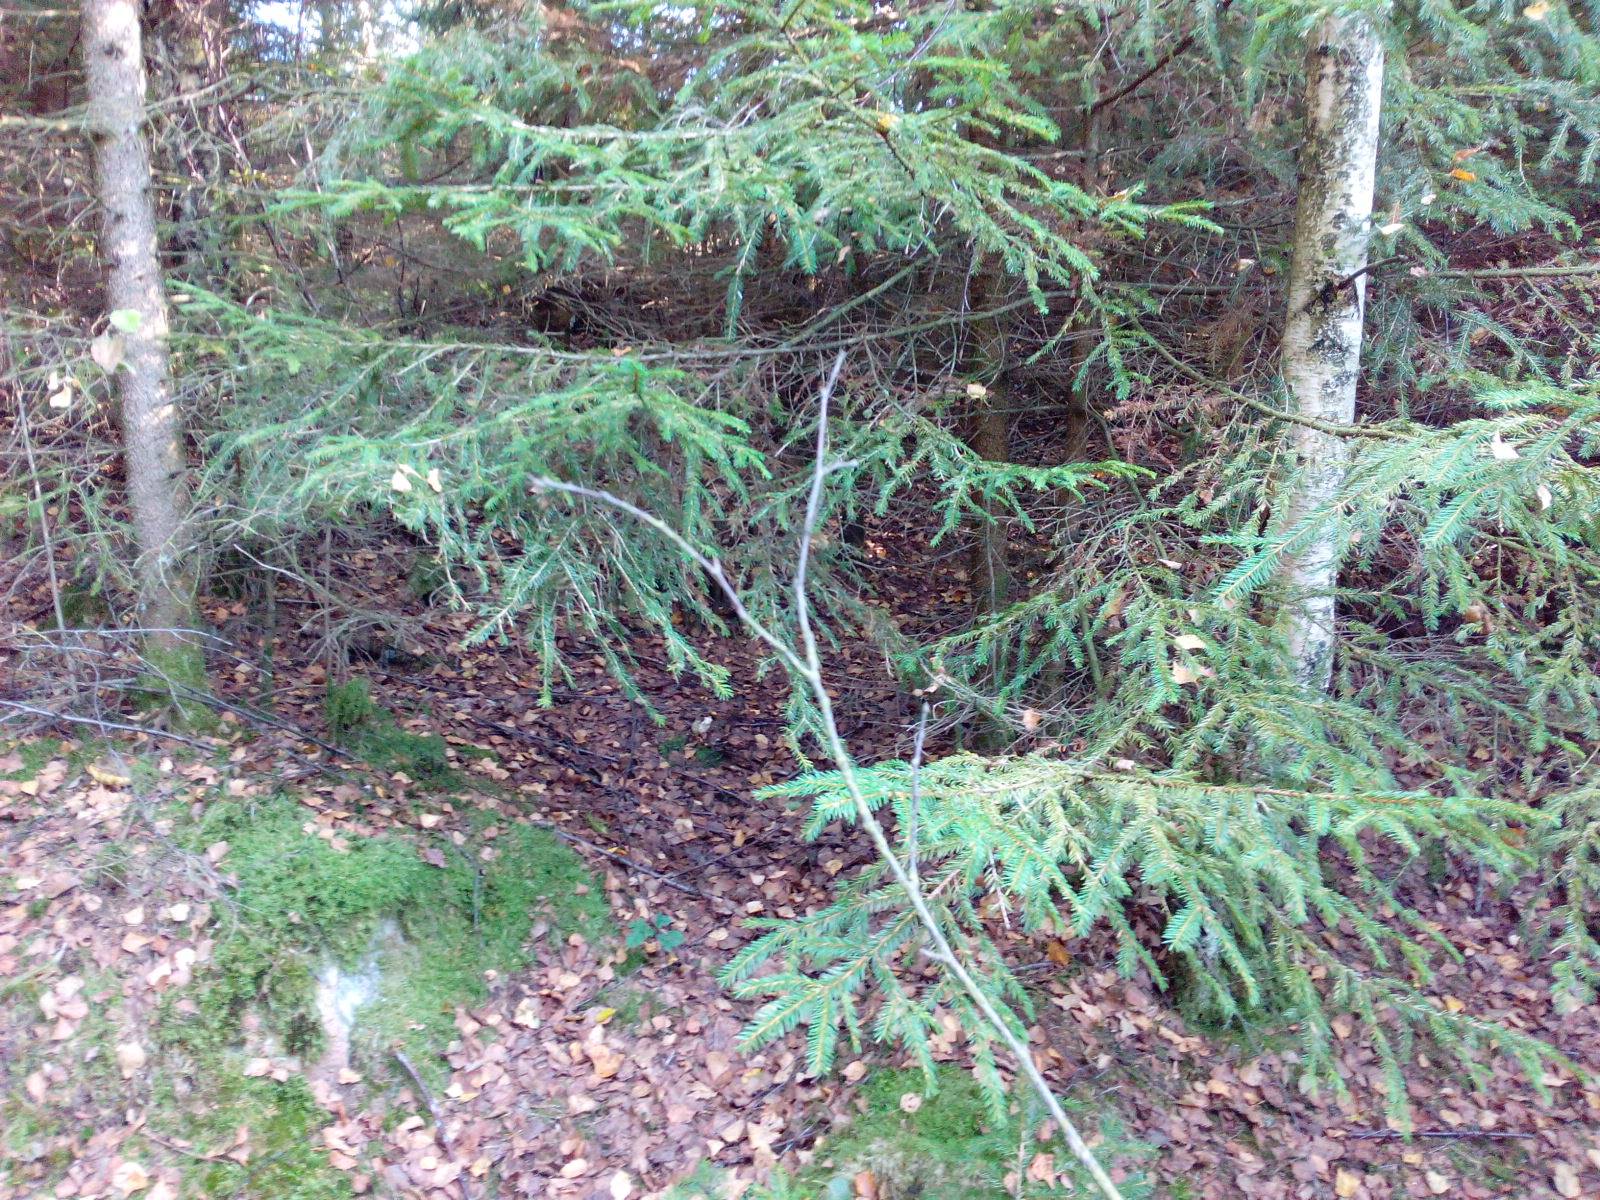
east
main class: Woodland
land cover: Other mixed woodland
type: hemiboreal forest and nemoral coniferous forest and mixed broadleaved-coniferous forest
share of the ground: > 75 %
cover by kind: coniferous forest trees 45 %, broadleaved forest trees 45 %, lichens and mosses 10 %
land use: Forestry
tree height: > 5 m
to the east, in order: Other mixed woodland; Broadleaved woodland; Tracks; Grassland with sparse tree/shrub cover; Spruce dominated coniferous woodland
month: October
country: SE
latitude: 56.6000
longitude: 13.1080
